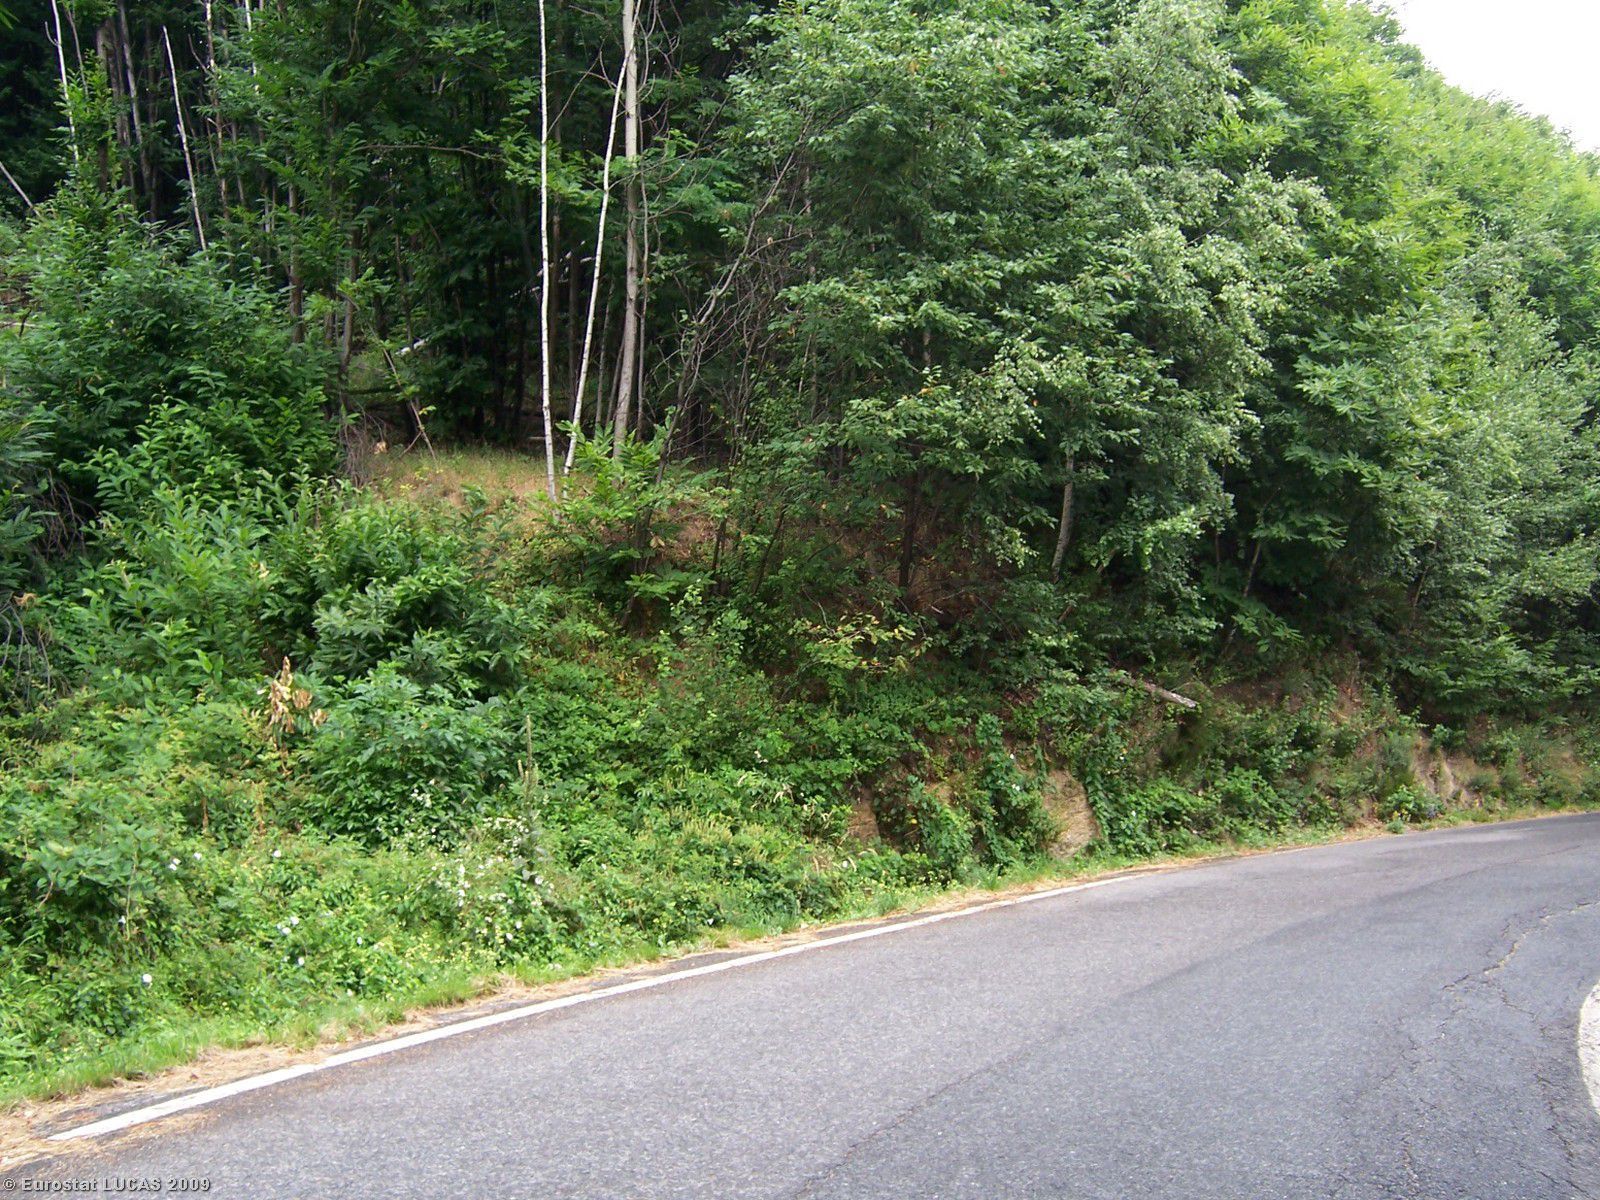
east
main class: Woodland
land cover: Broadleaved woodland
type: mesophytic deciduous forest
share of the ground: 50 - 75 %
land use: Unused
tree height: > 5 m
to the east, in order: Broadleaved woodland; Paved roads, cycling and walking lanes; Broadleaved woodland; Tracks; Broadleaved woodland; Artificial constructions in urban areas; Broadleaved woodland
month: July
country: IT
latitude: 45.0197
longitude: 7.3270
